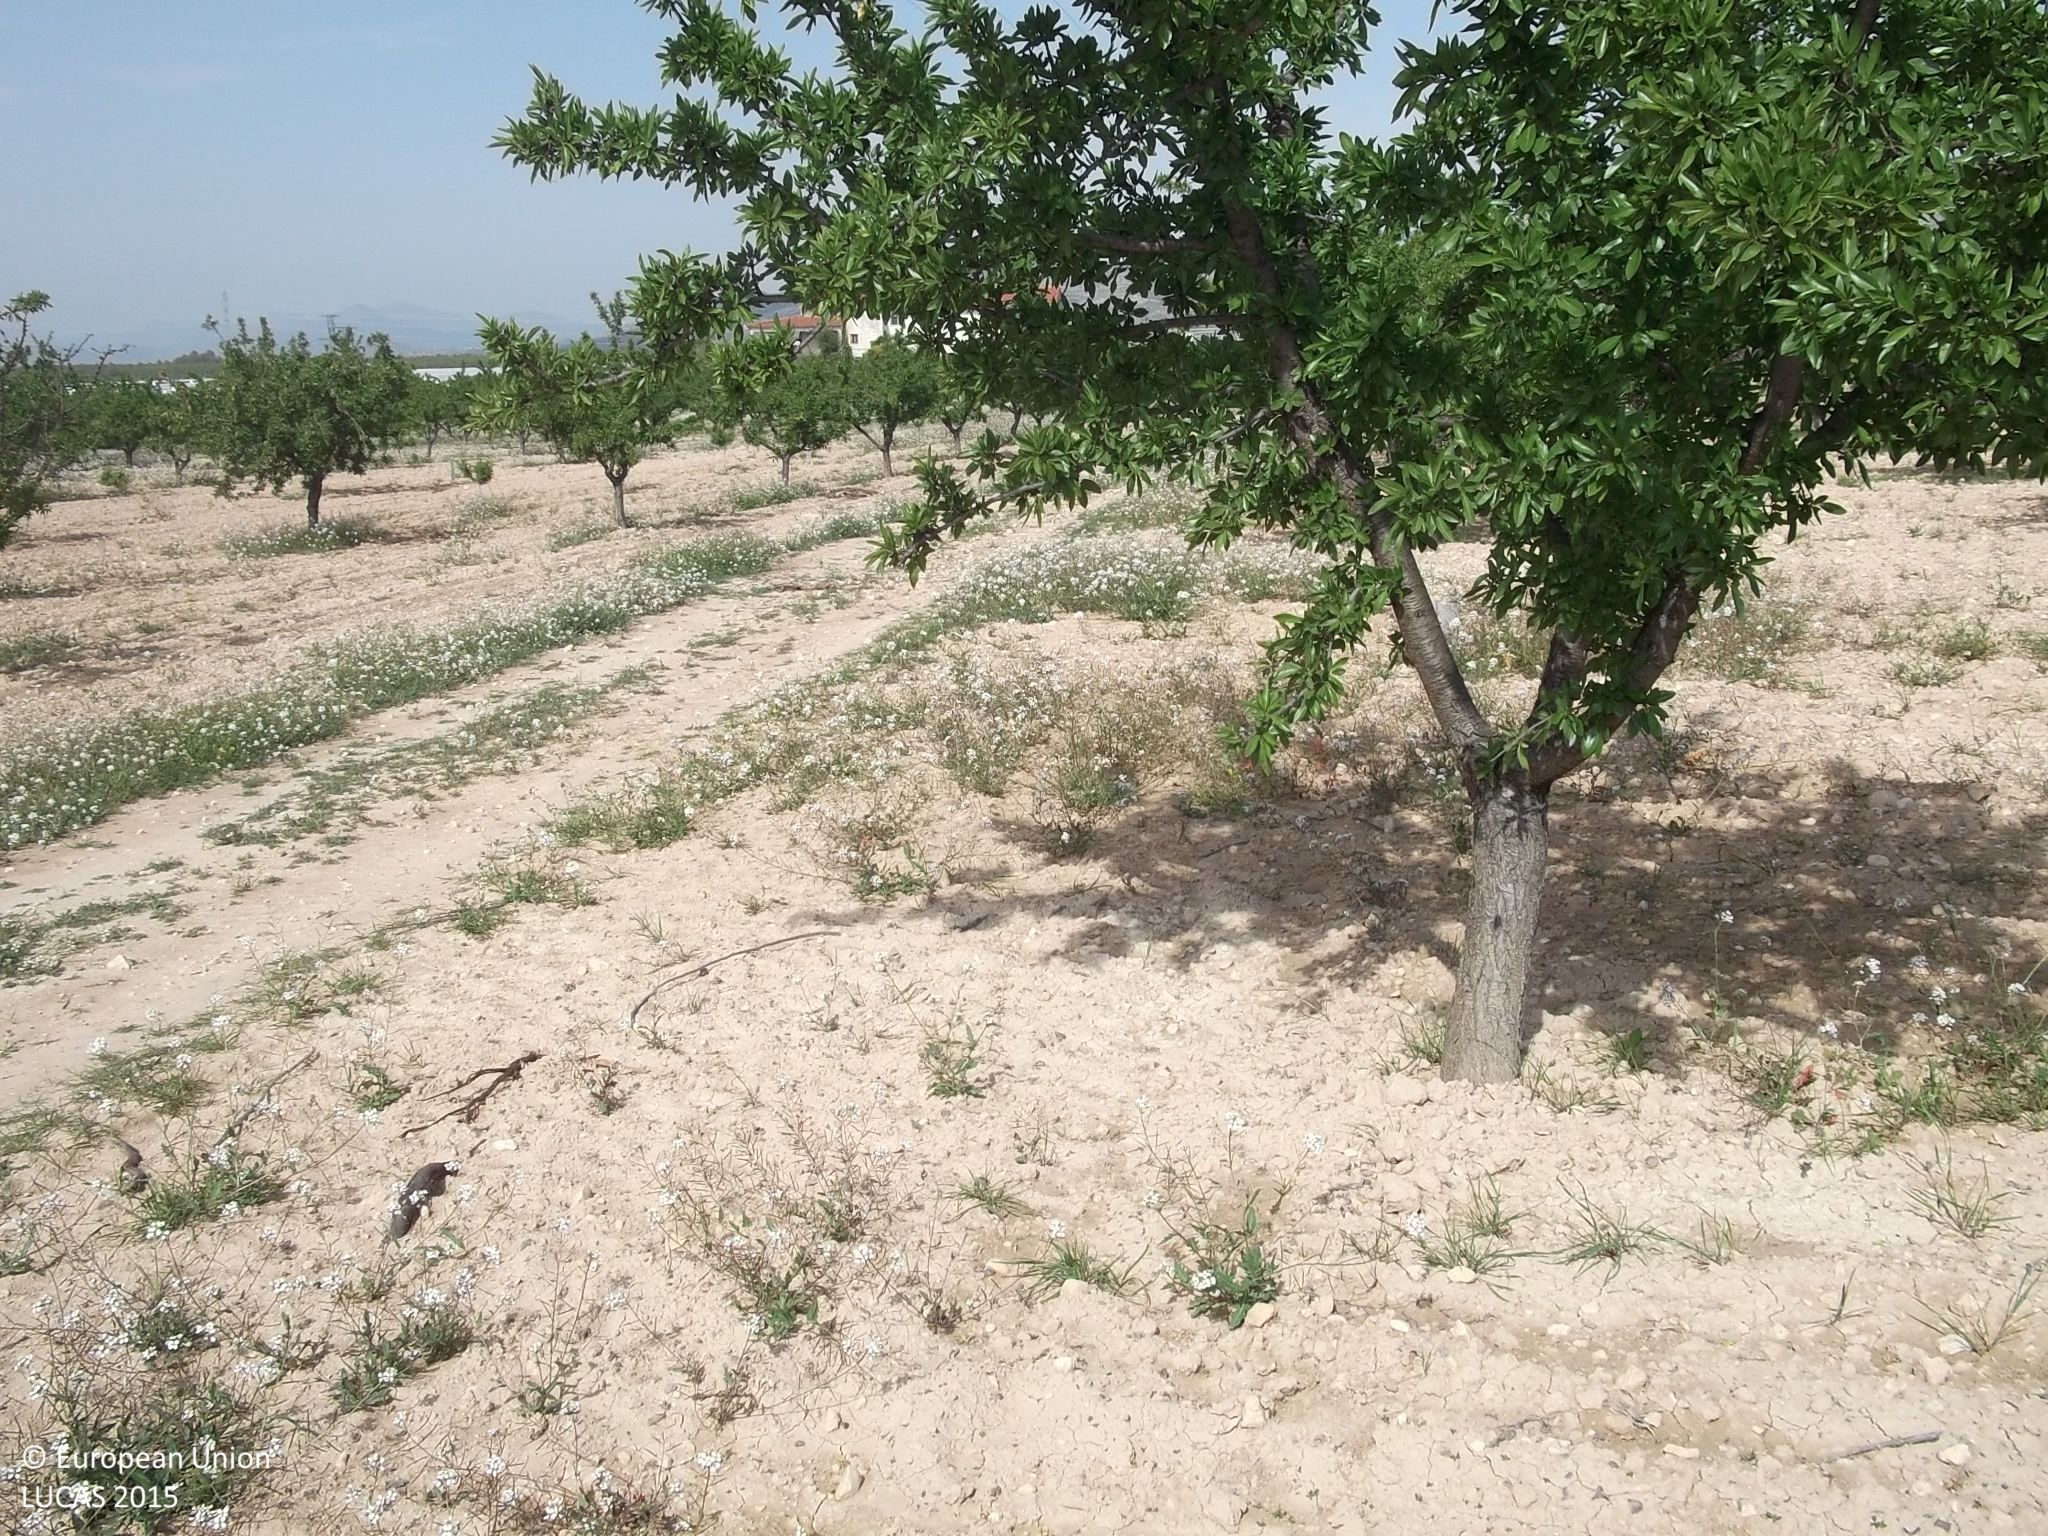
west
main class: Cropland
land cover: Nuts trees
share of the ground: 10 - 25 %
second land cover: Other bare soil
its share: > 75 %
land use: Agriculture (excluding fallow land and kitchen gardens)
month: April
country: ES
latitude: 38.2801
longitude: -1.5930
